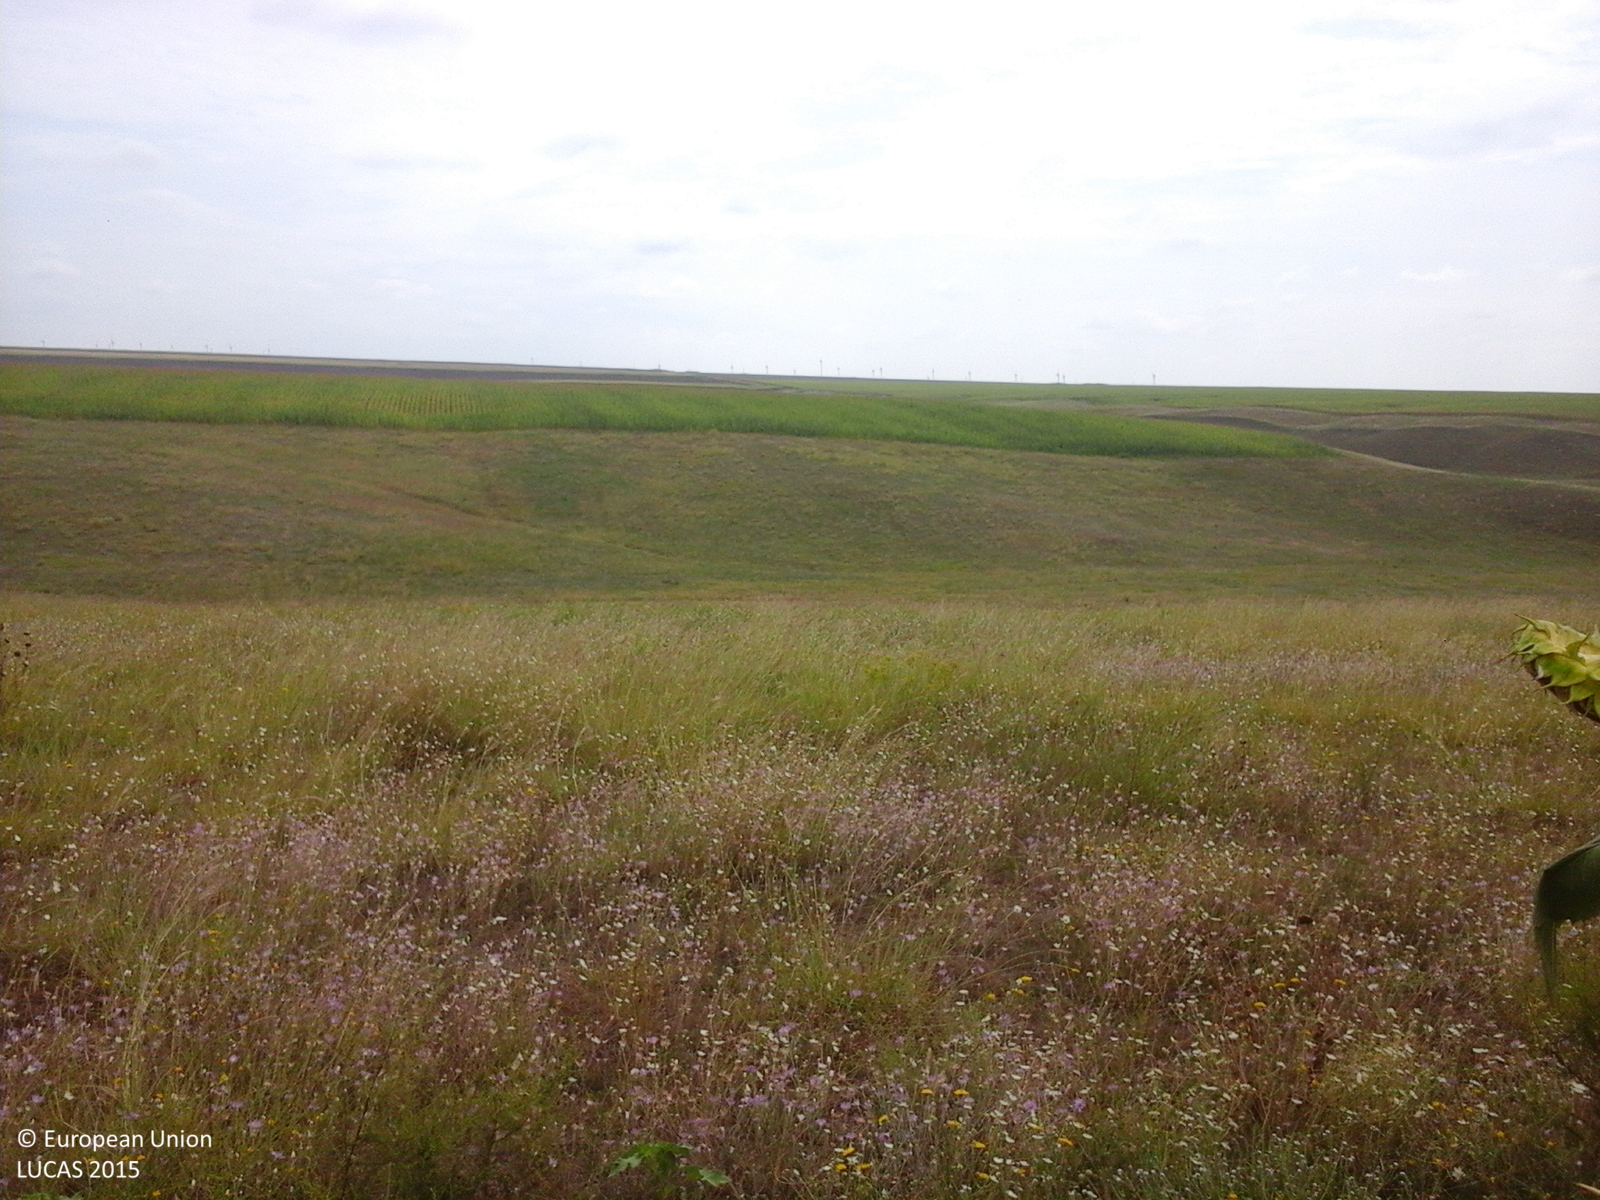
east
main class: Cropland
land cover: Sunflower
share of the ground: > 75 %
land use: Agriculture (excluding fallow land and kitchen gardens)
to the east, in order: Sunflower; Grassland without tree/shrub cover
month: August
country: RO
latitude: 44.8032
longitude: 28.1307
